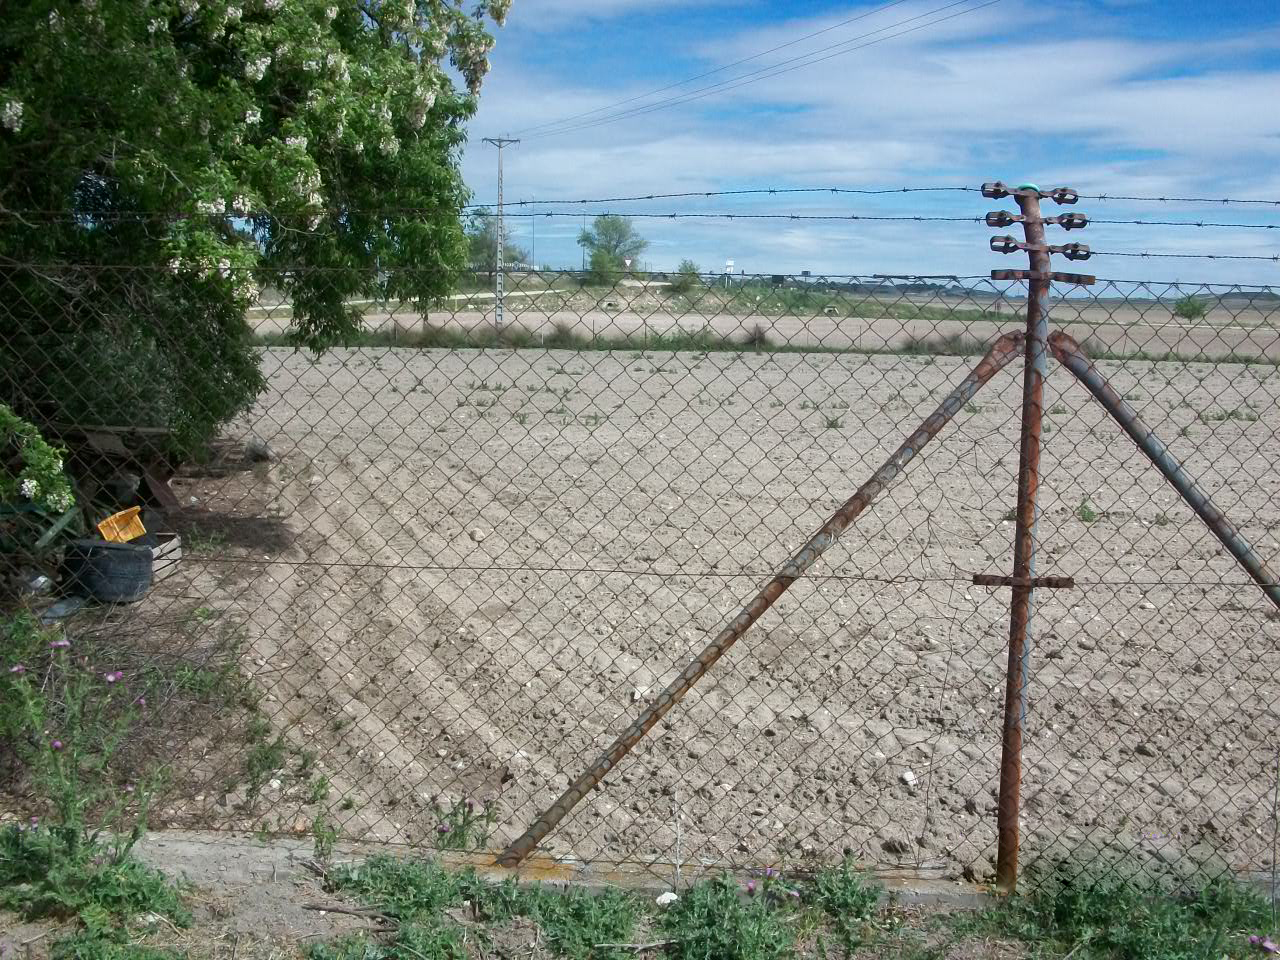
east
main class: Woodland
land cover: Broadleaved woodland
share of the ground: 50 - 75 %
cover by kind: broadleaved forest trees 60 %, herbaceous plants 40 %
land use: Residential
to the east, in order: Broadleaved woodland; Spontaneously vegetated surfaces; Electric lines; Spontaneously vegetated surfaces; Grassland without tree/shrub cover; Electric lines; Grassland without tree/shrub cover; Other bare soil; Electric lines; Other bare soil; Grass margins; Tracks; Grass margins; Artificial constructions in urban areas
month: May
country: ES
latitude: 40.2349
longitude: -3.7047
